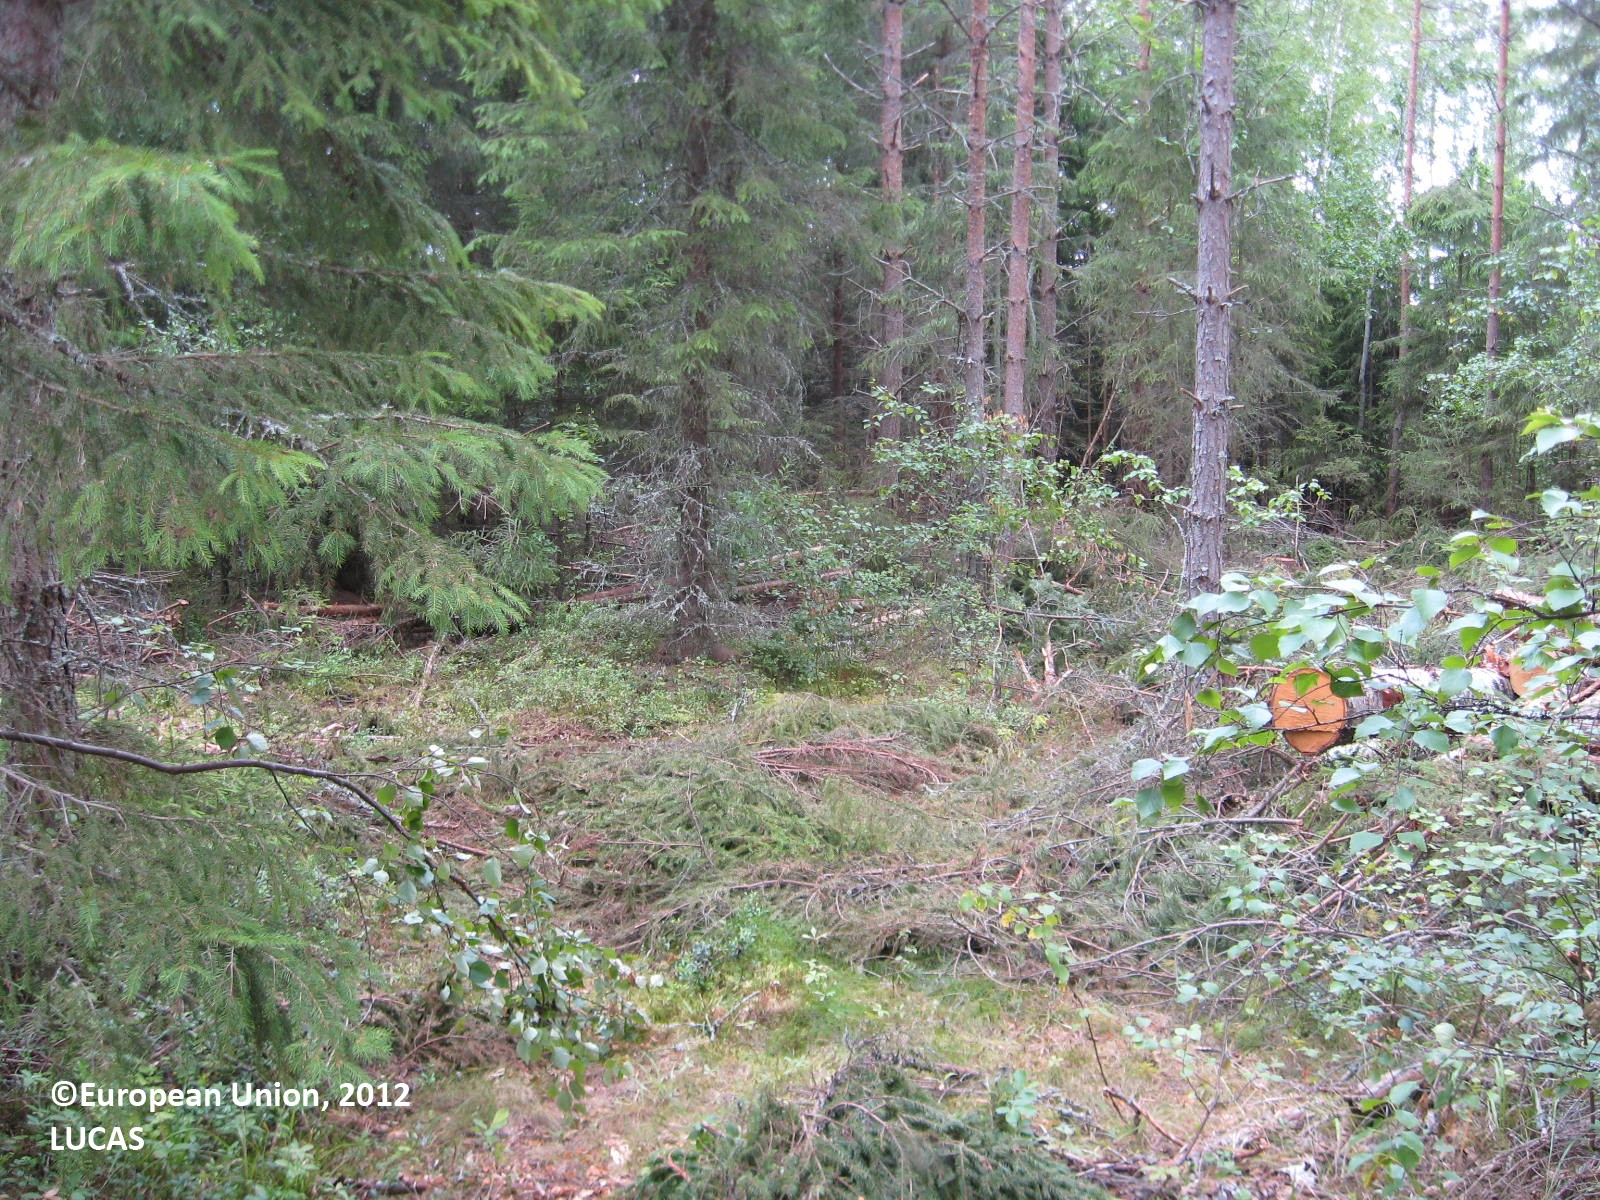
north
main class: Woodland
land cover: Other coniferous woodland
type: boreal forest
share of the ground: > 75 %
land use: Forestry
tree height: > 5 m
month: July
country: FI
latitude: 61.9155
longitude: 21.4912
